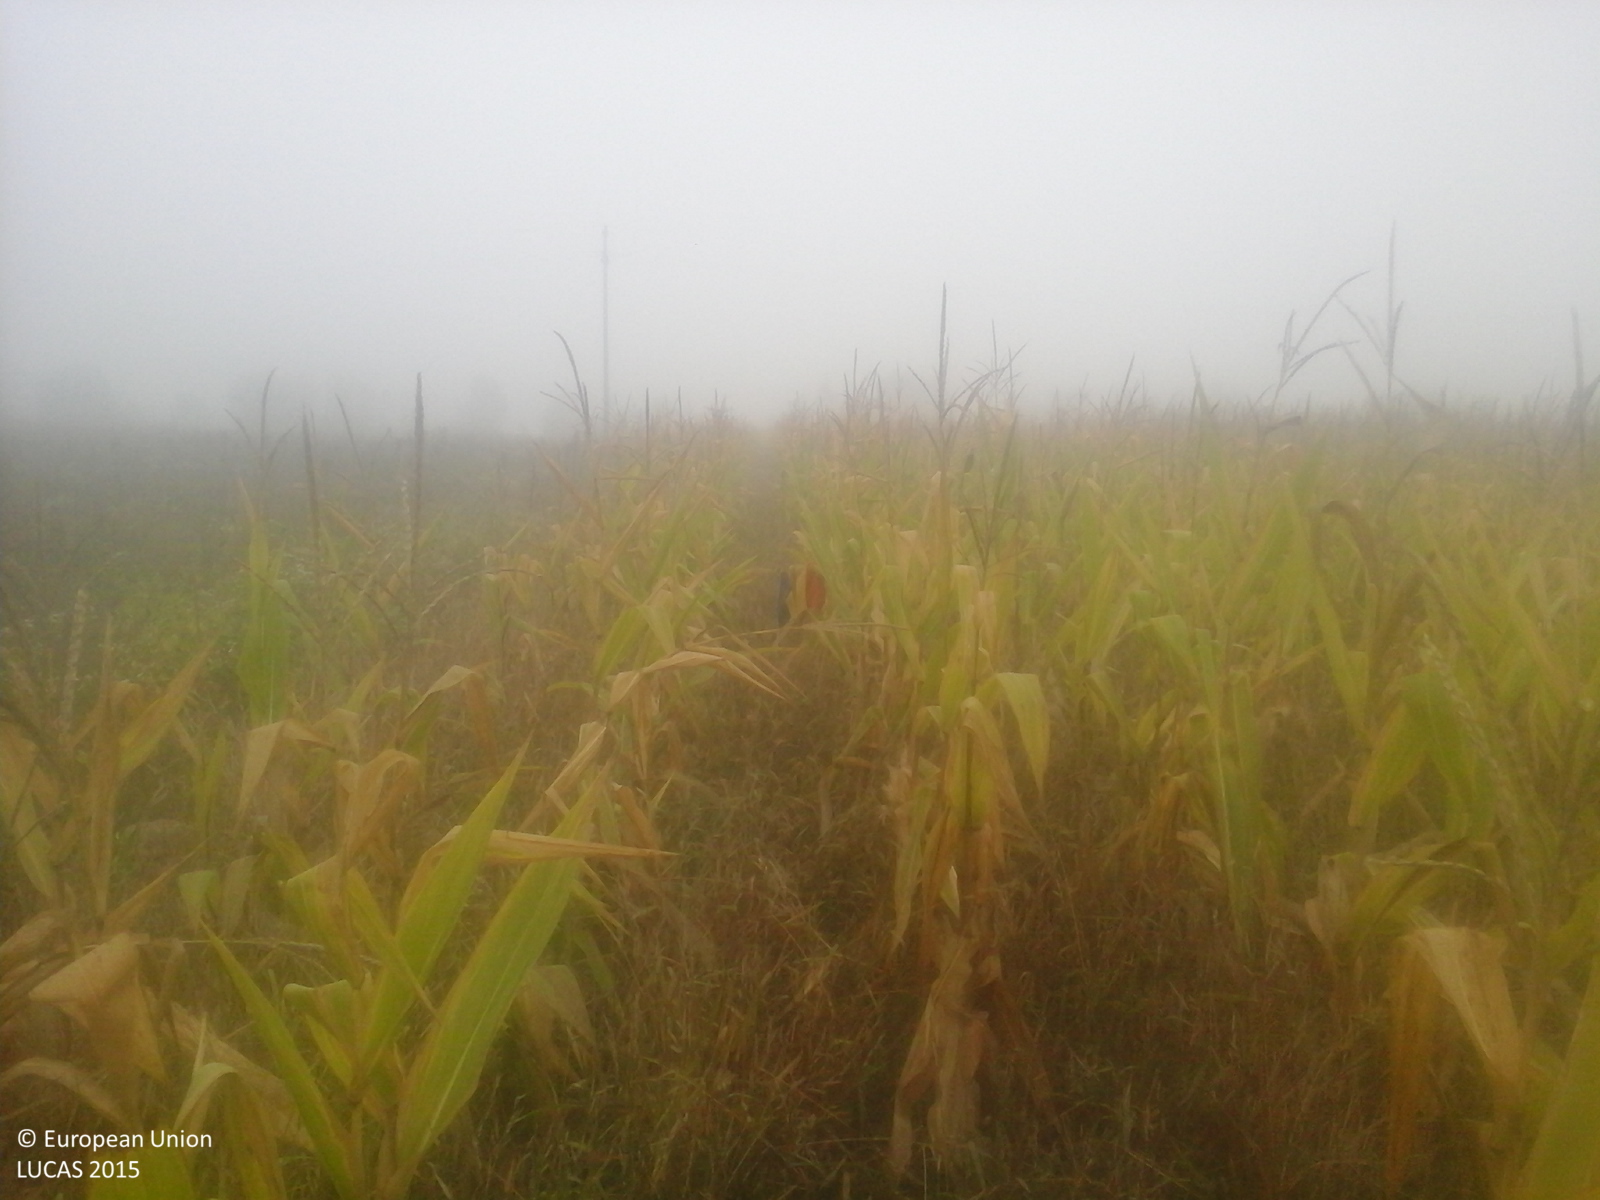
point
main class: Cropland
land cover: Maize
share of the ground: > 75 %
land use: Agriculture (excluding fallow land and kitchen gardens)
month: September
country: RO
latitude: 45.5852
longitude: 21.9713
